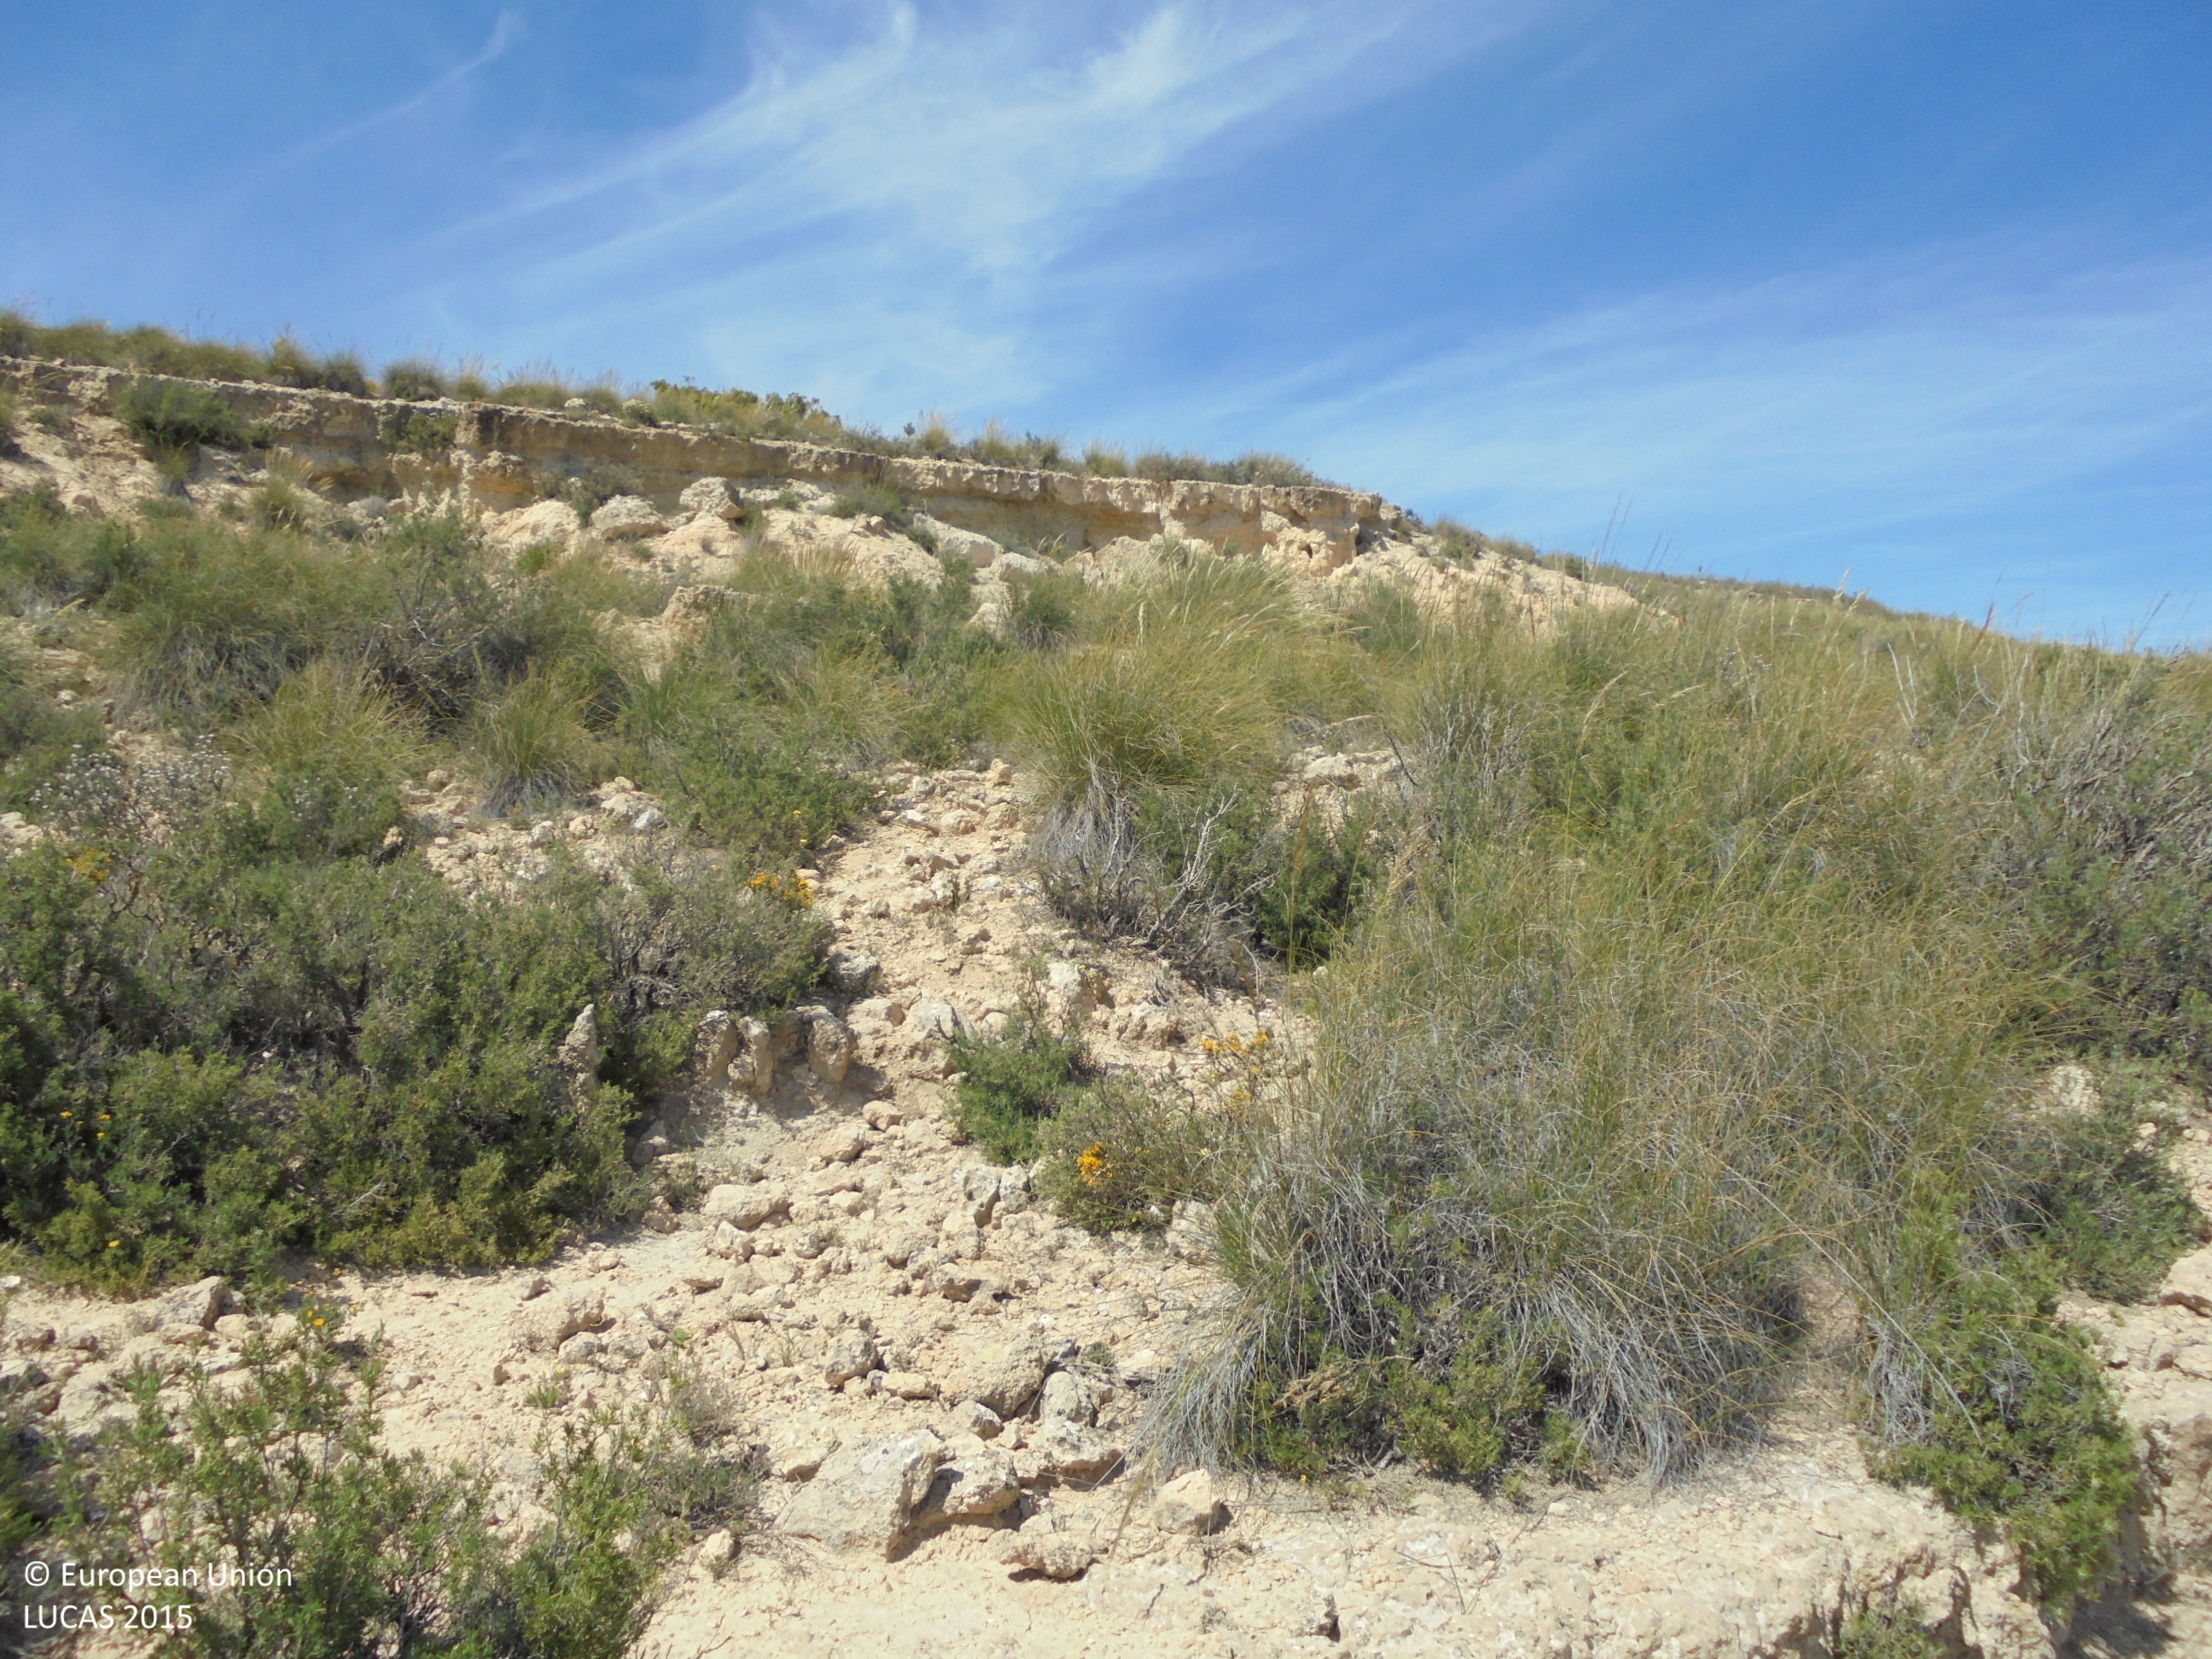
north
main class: Shrubland
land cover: Shrubland without tree cover
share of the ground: 50 - 75 %
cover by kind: shrubs 50 %, consolidated bare surface 35 %, herbaceous plants 15 %
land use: Semi-natural and natural areas not in use
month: May
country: ES
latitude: 39.1530
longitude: -1.6303
